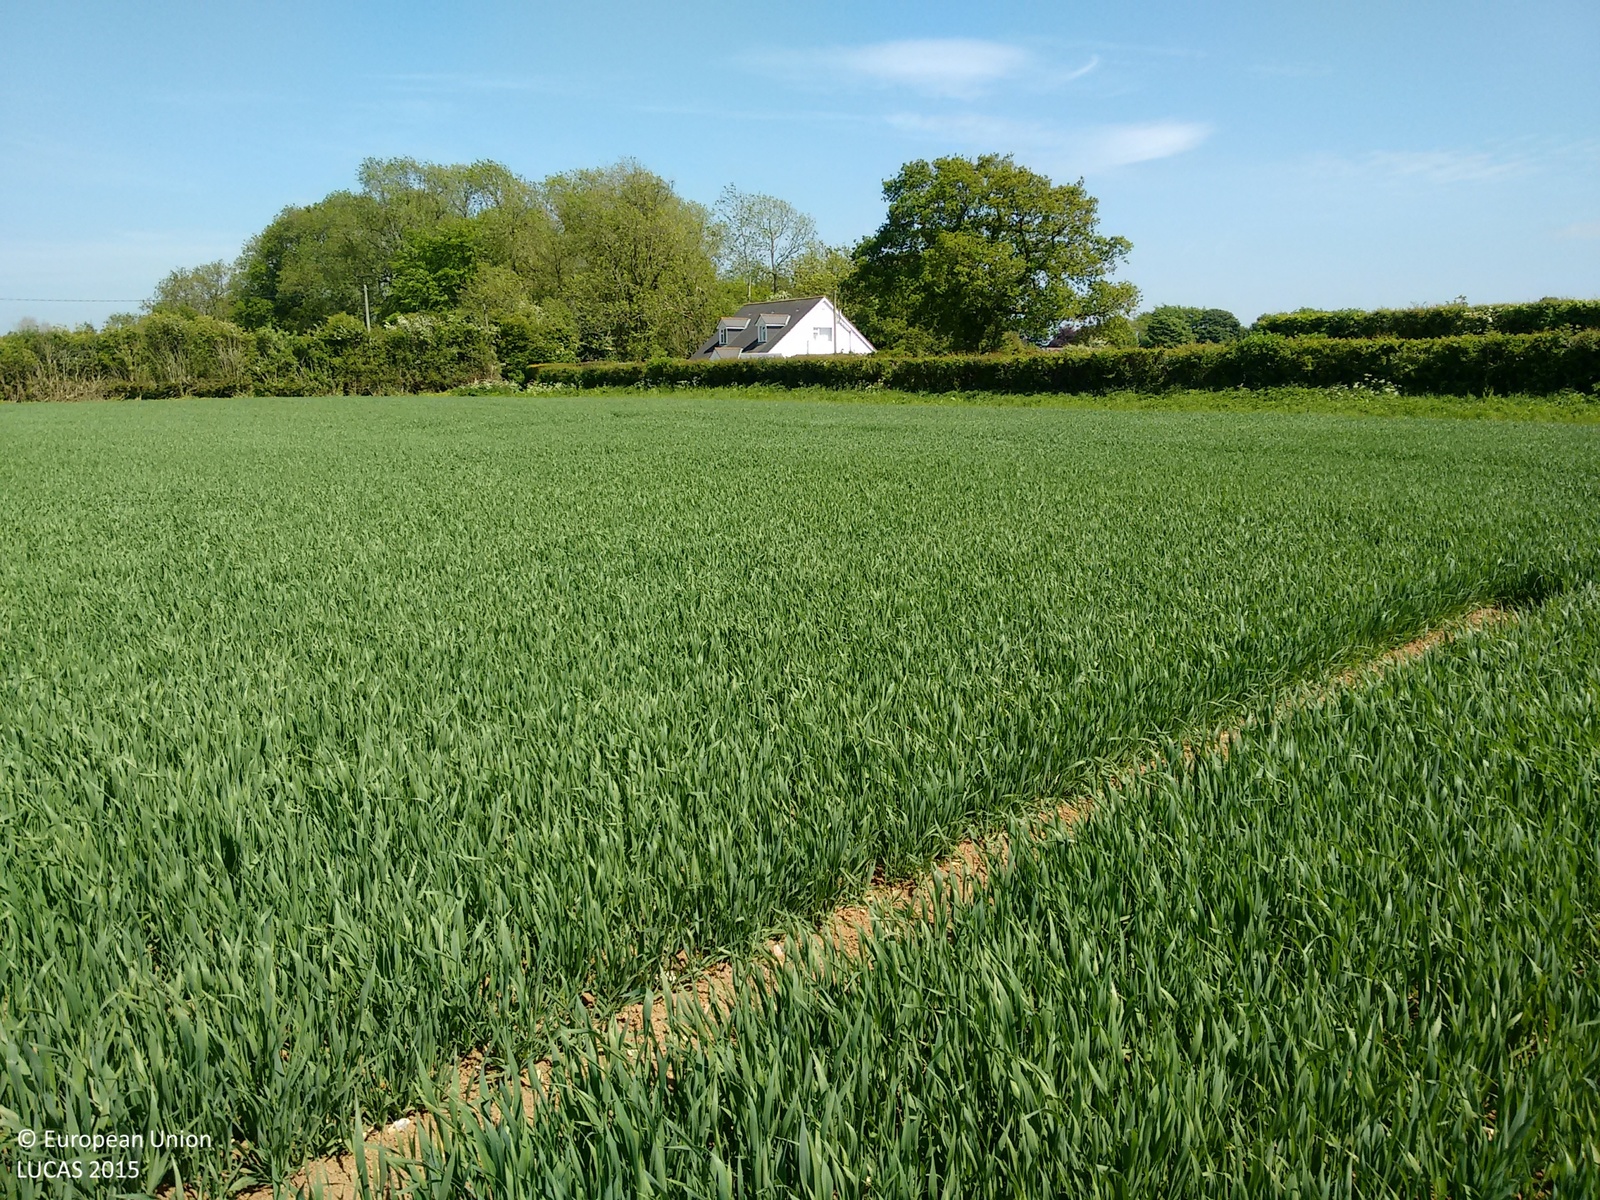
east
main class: Cropland
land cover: Common wheat
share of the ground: > 75 %
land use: Agriculture (excluding fallow land and kitchen gardens)
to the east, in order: Common wheat; Grassland without tree/shrub cover; Managed hedges; Grass margins; Paved roads, cycling and walking lanes; Grass margins; Managed hedges; Grassland without tree/shrub cover; Artificial constructions in urban areas; Broadleaved woodland; Grassland without tree/shrub cover
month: May
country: GB
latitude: 51.1427
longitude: 1.1587
